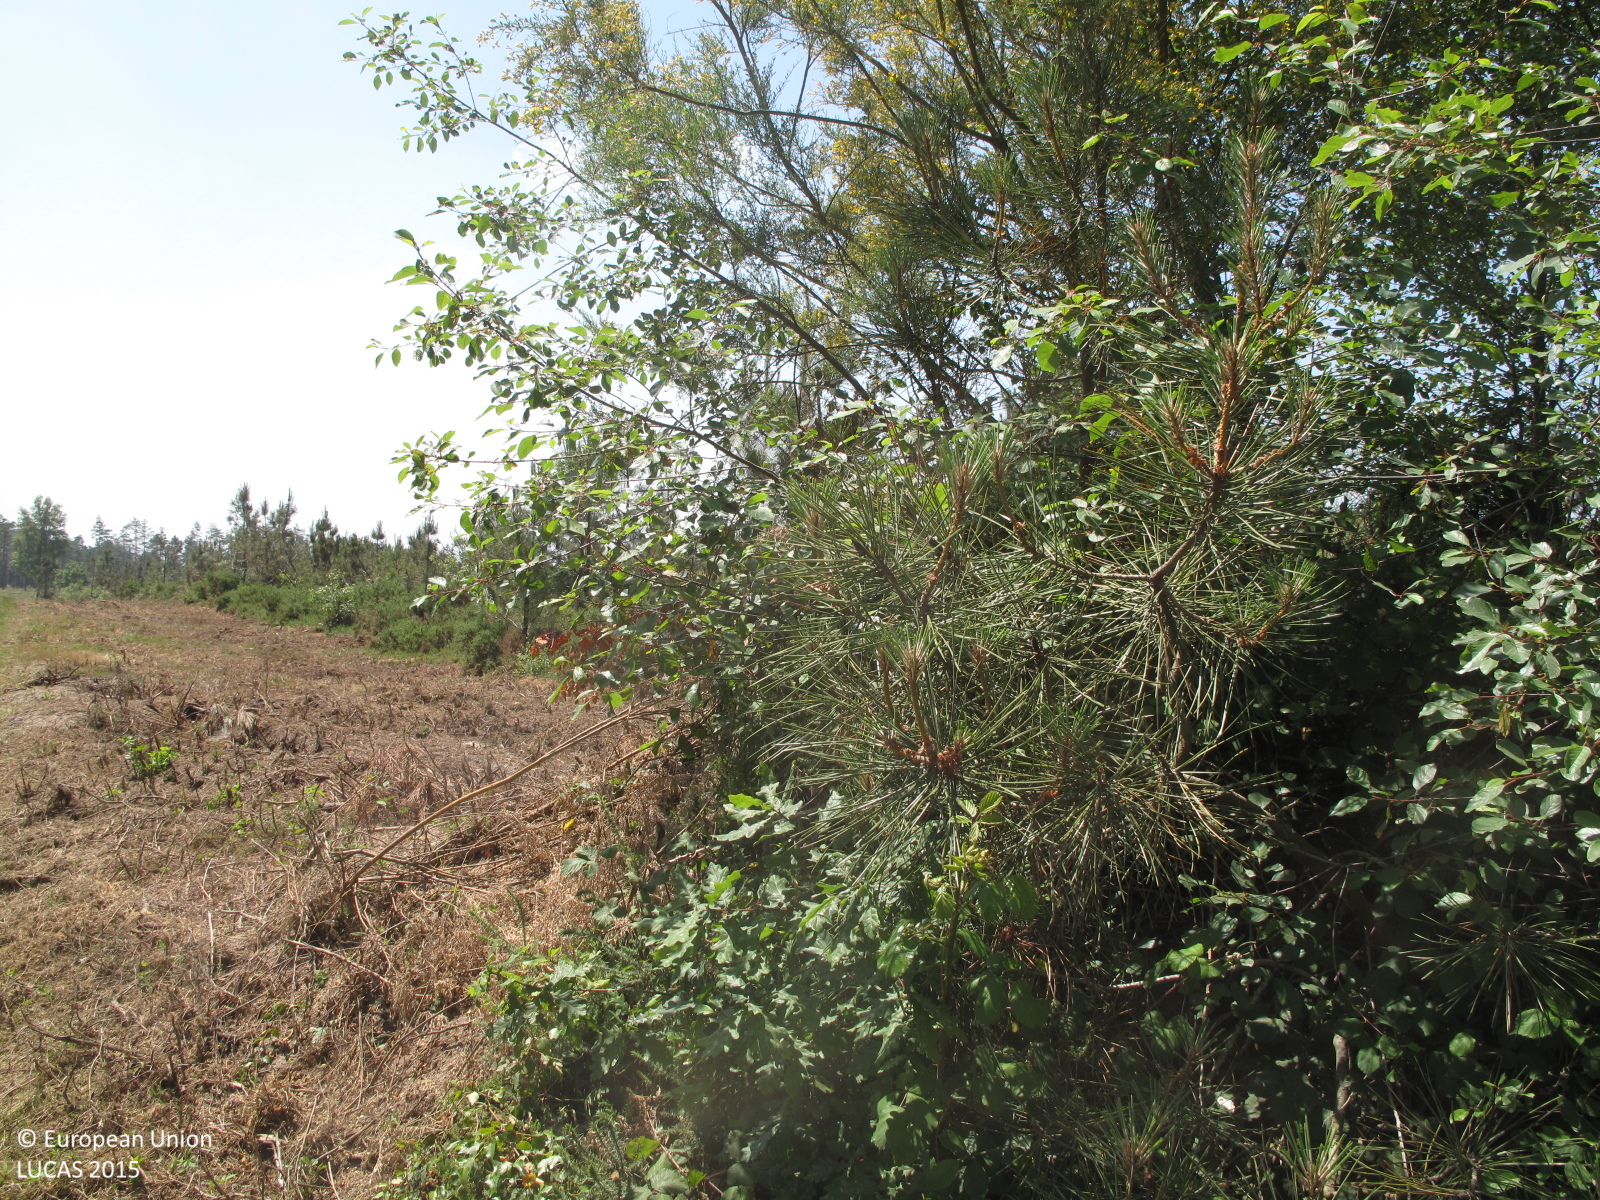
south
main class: Woodland
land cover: Pine dominated mixed woodland
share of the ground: 10 - 25 %
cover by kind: shrubs 60 %, herbaceous plants 30 %, coniferous forest trees 5 %, broadleaved forest trees 5 %
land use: Forestry
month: June
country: ES
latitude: 43.2336
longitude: -7.9330
